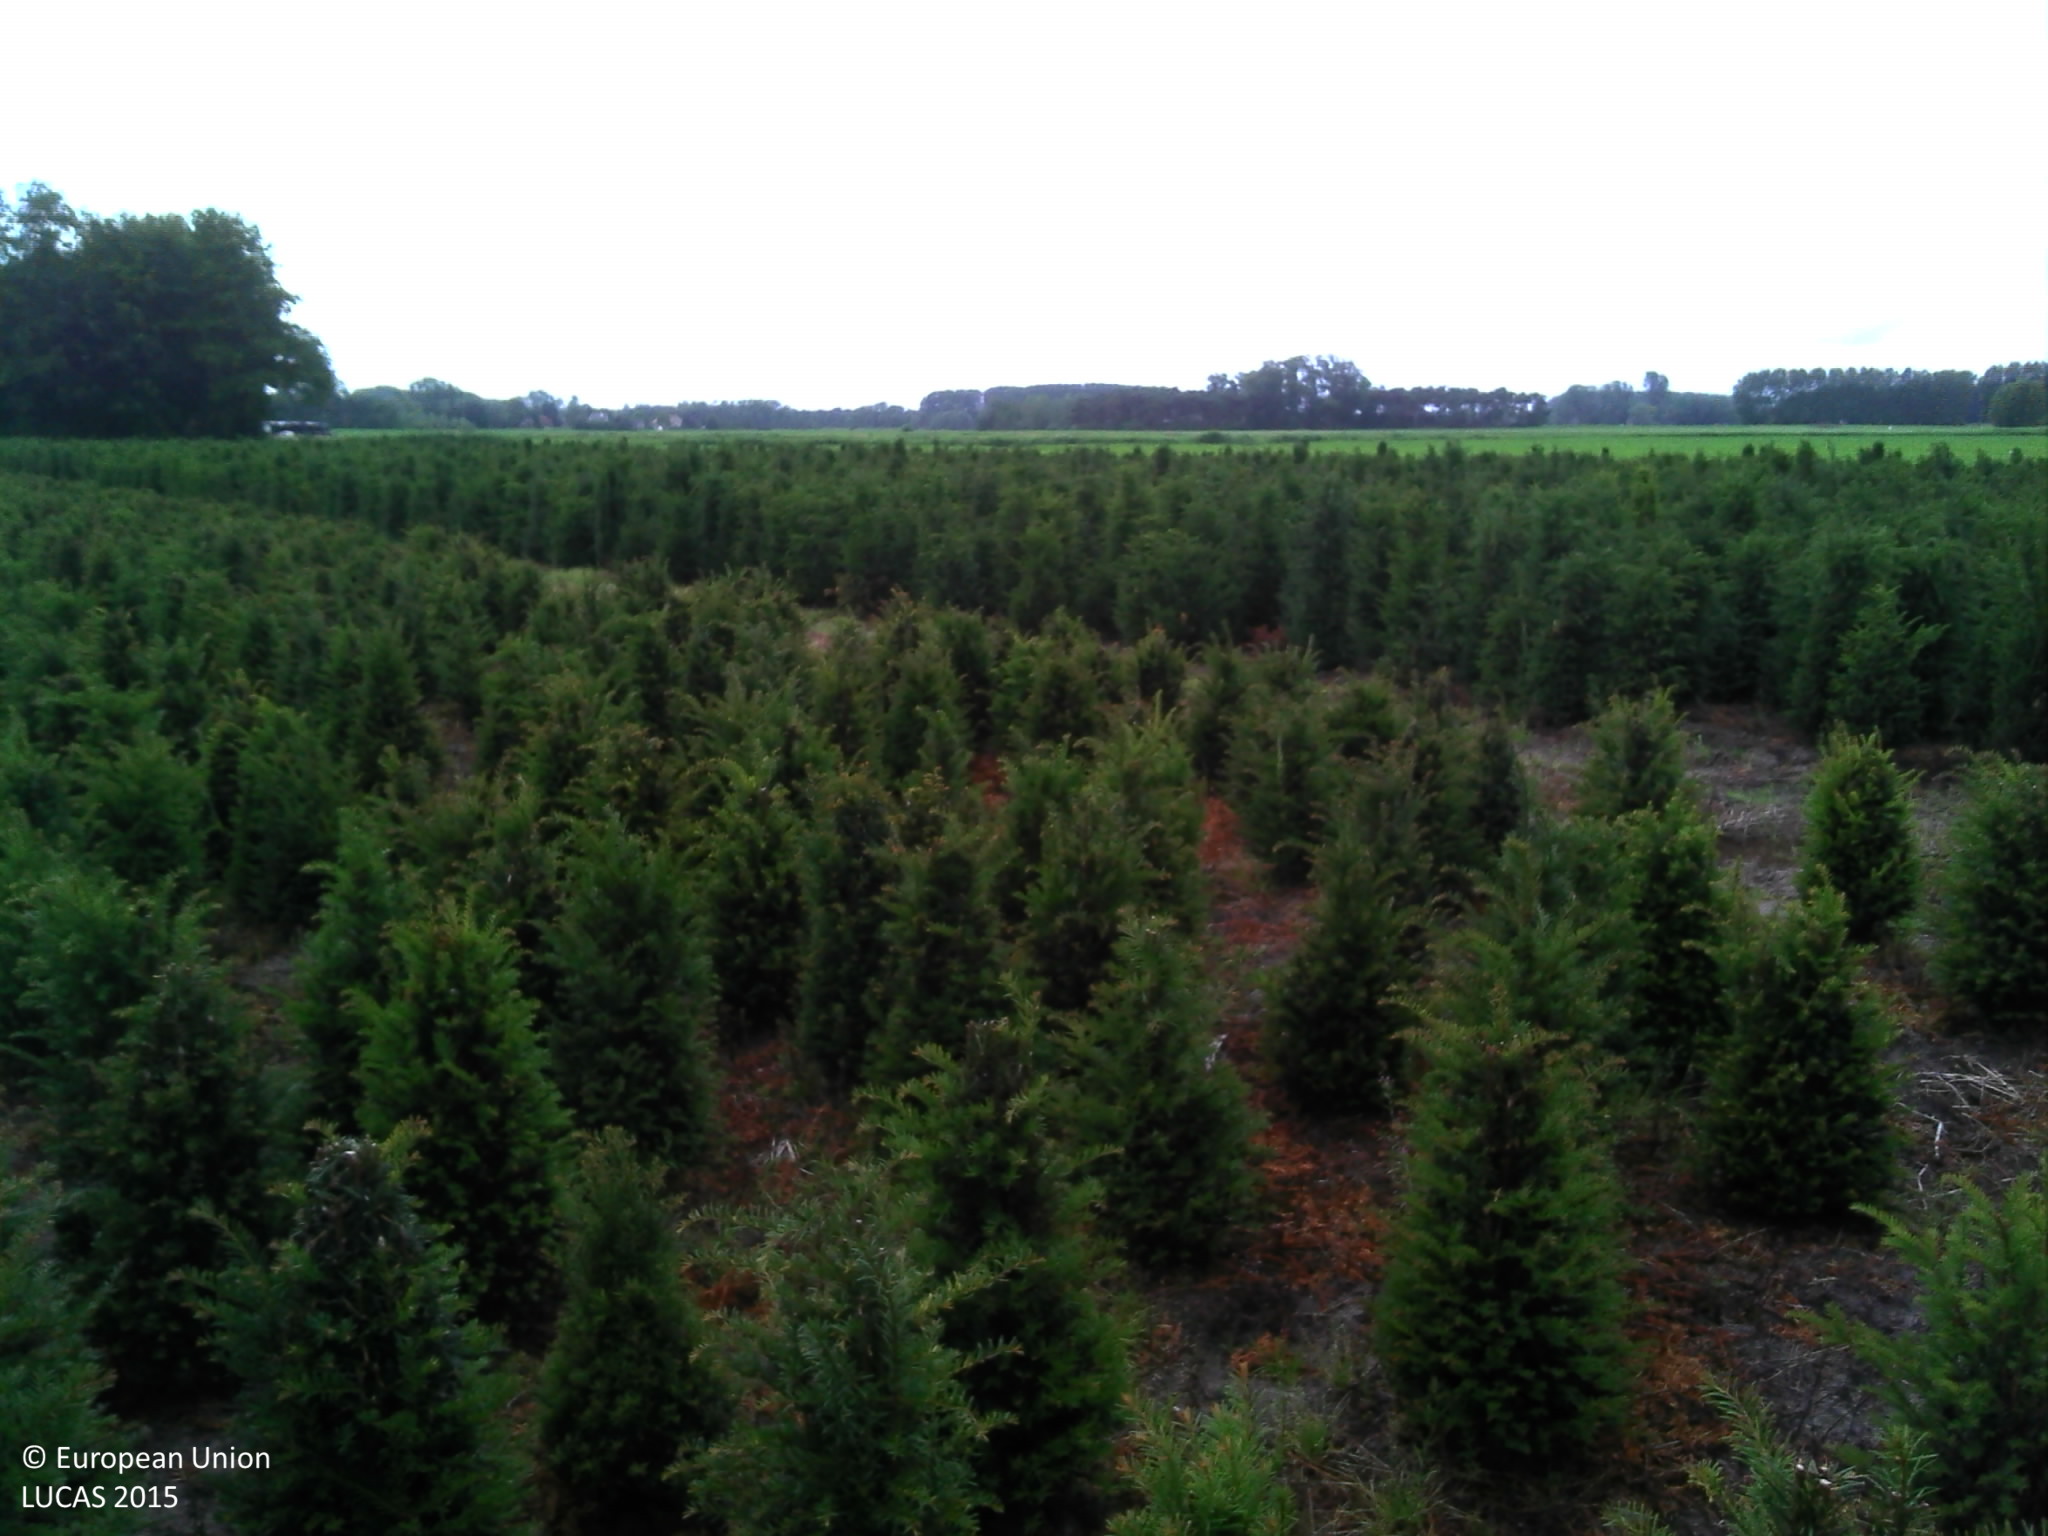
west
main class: Cropland
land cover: Nurseries
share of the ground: > 75 %
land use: Agriculture (excluding fallow land and kitchen gardens)
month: June
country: BE
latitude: 51.2101
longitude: 3.8814
